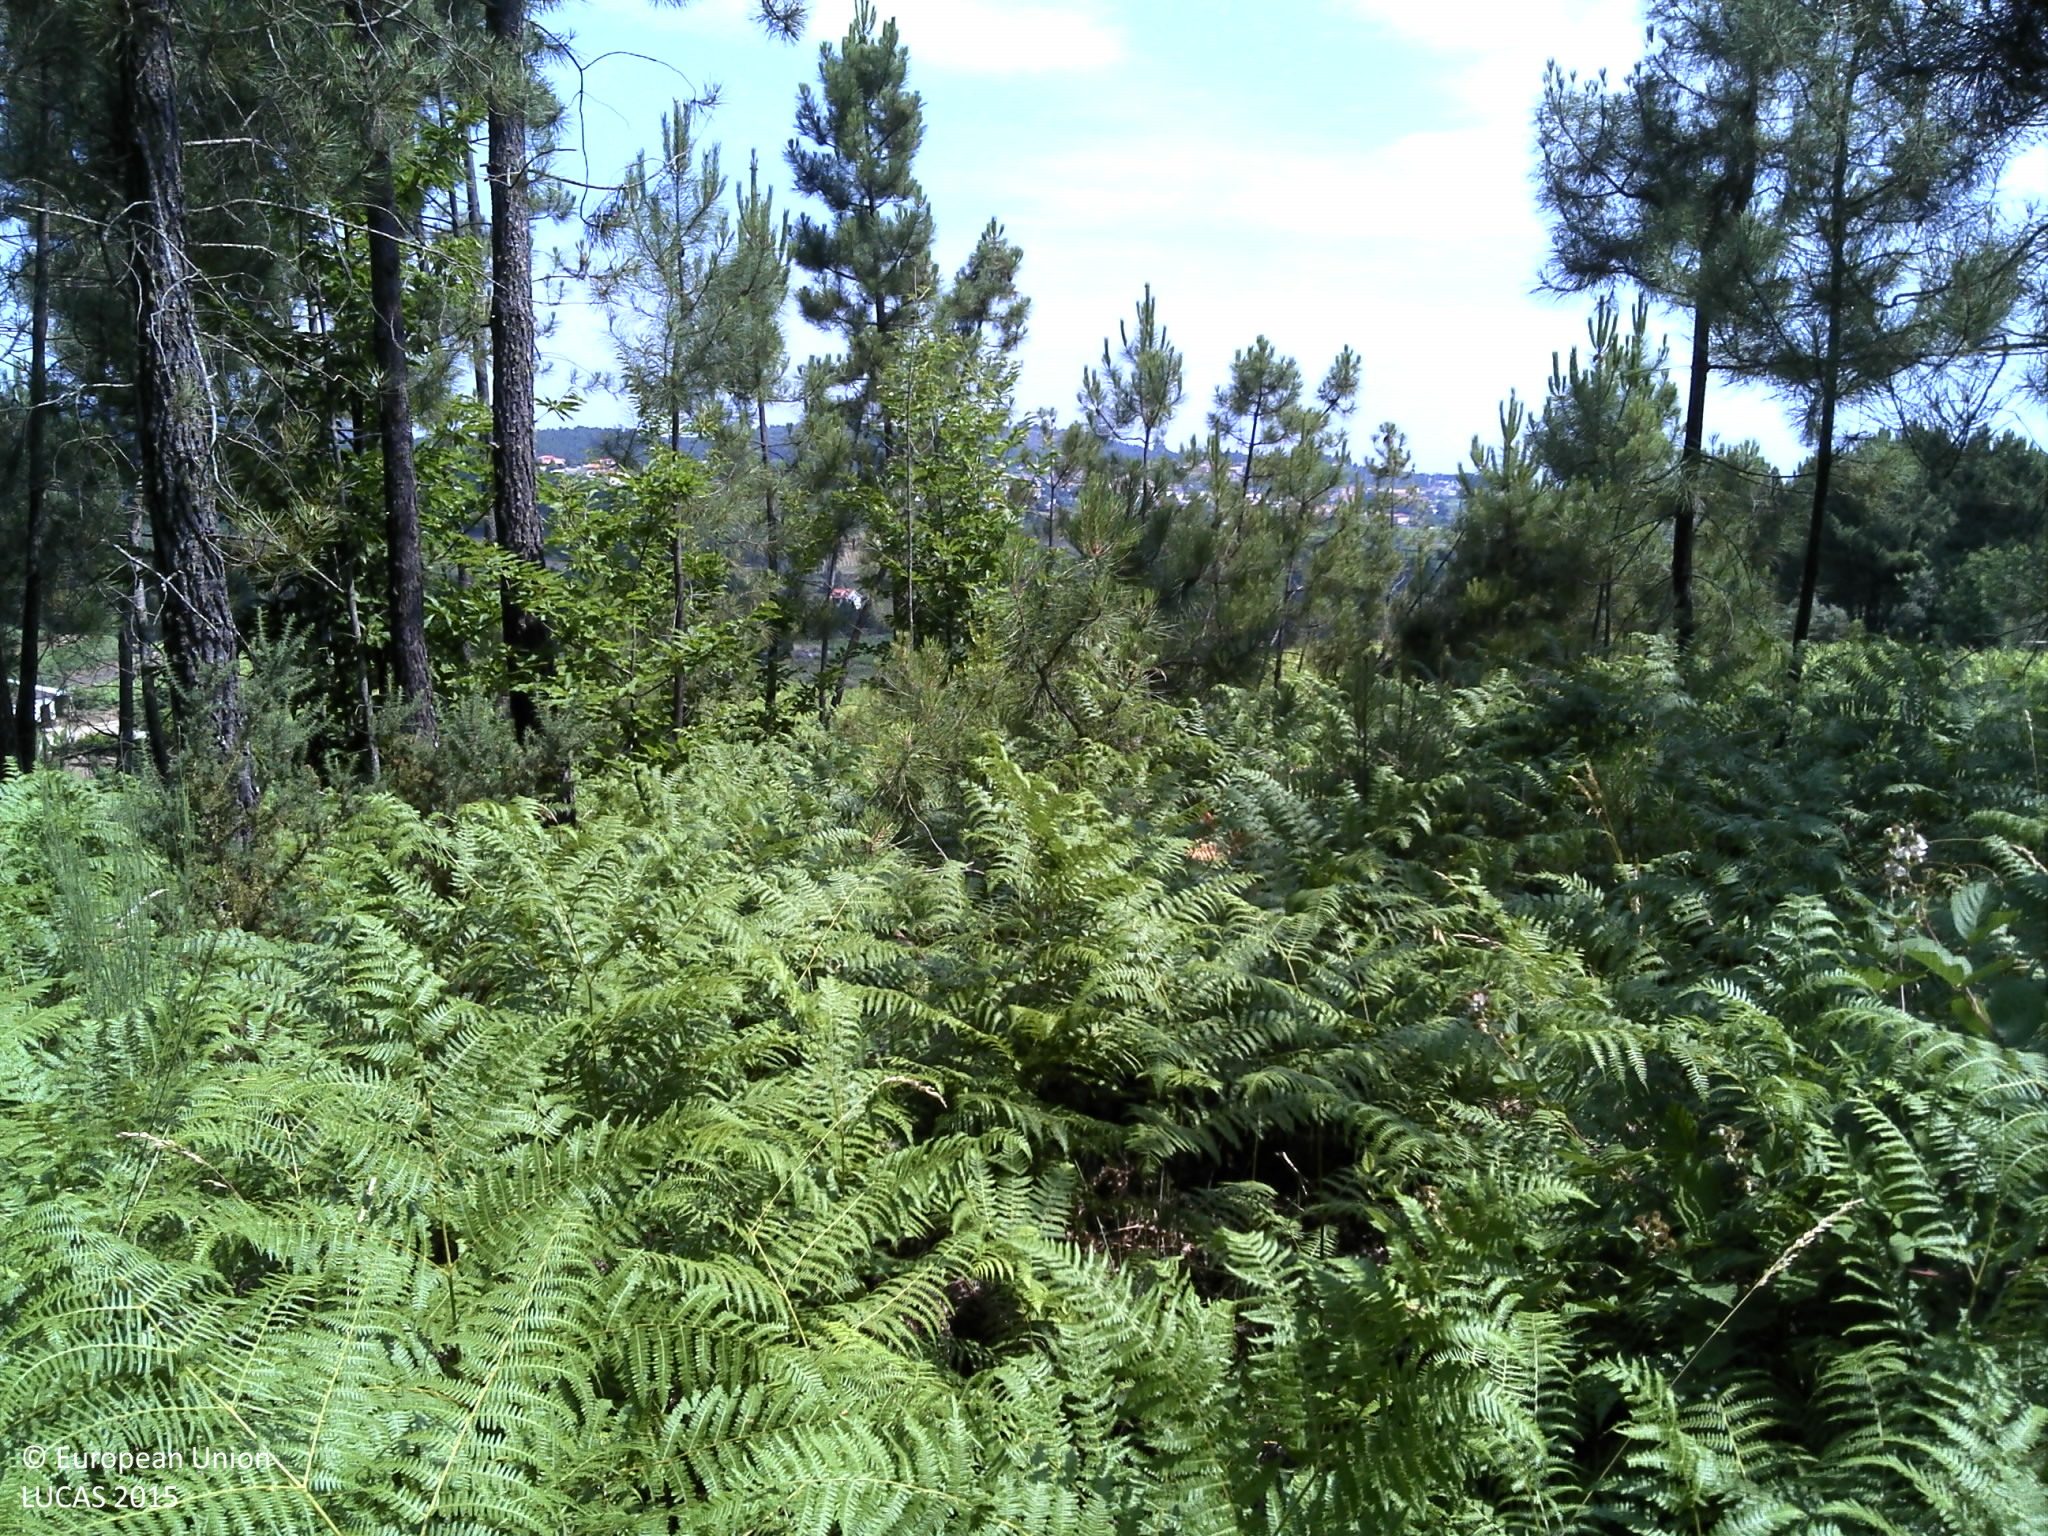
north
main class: Woodland
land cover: Pine dominated coniferous woodland
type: coniferous forest of the mediterranean region
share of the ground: 25 - 50 %
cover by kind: shrubs 70 %, coniferous forest trees 30 %
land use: Forestry
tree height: > 5 m
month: June
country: PT
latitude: 41.2489
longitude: -7.5842
